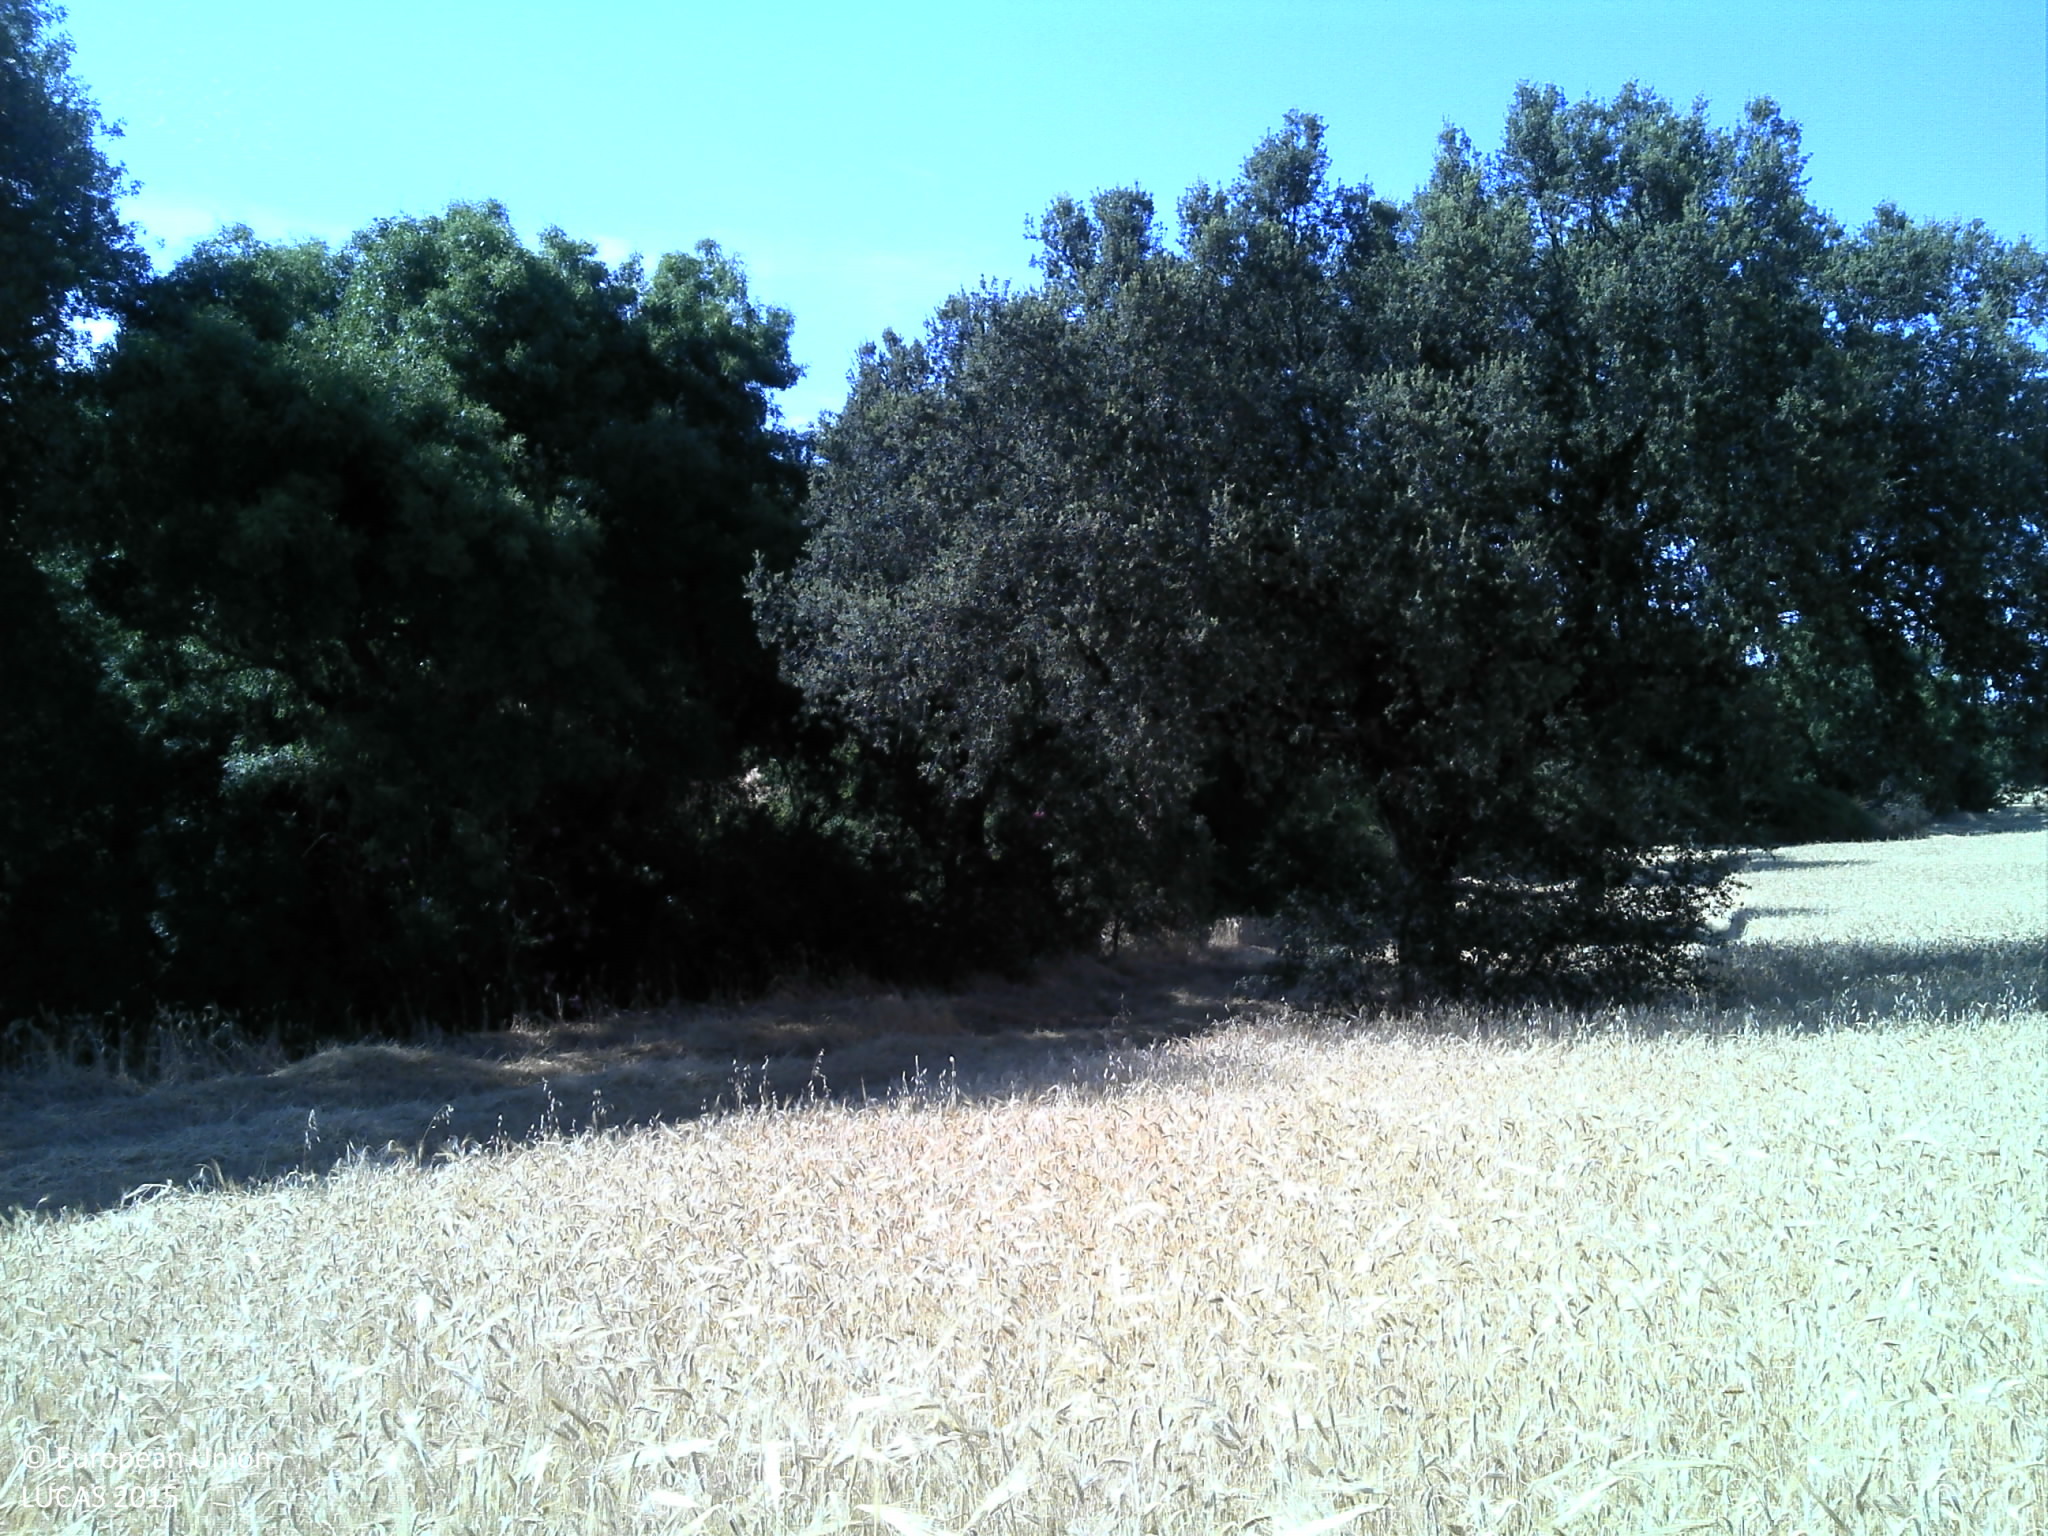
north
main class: Cropland
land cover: Triticale
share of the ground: > 75 %
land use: Agriculture (excluding fallow land and kitchen gardens)
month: July
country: PT
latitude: 38.4032
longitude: -7.7003
